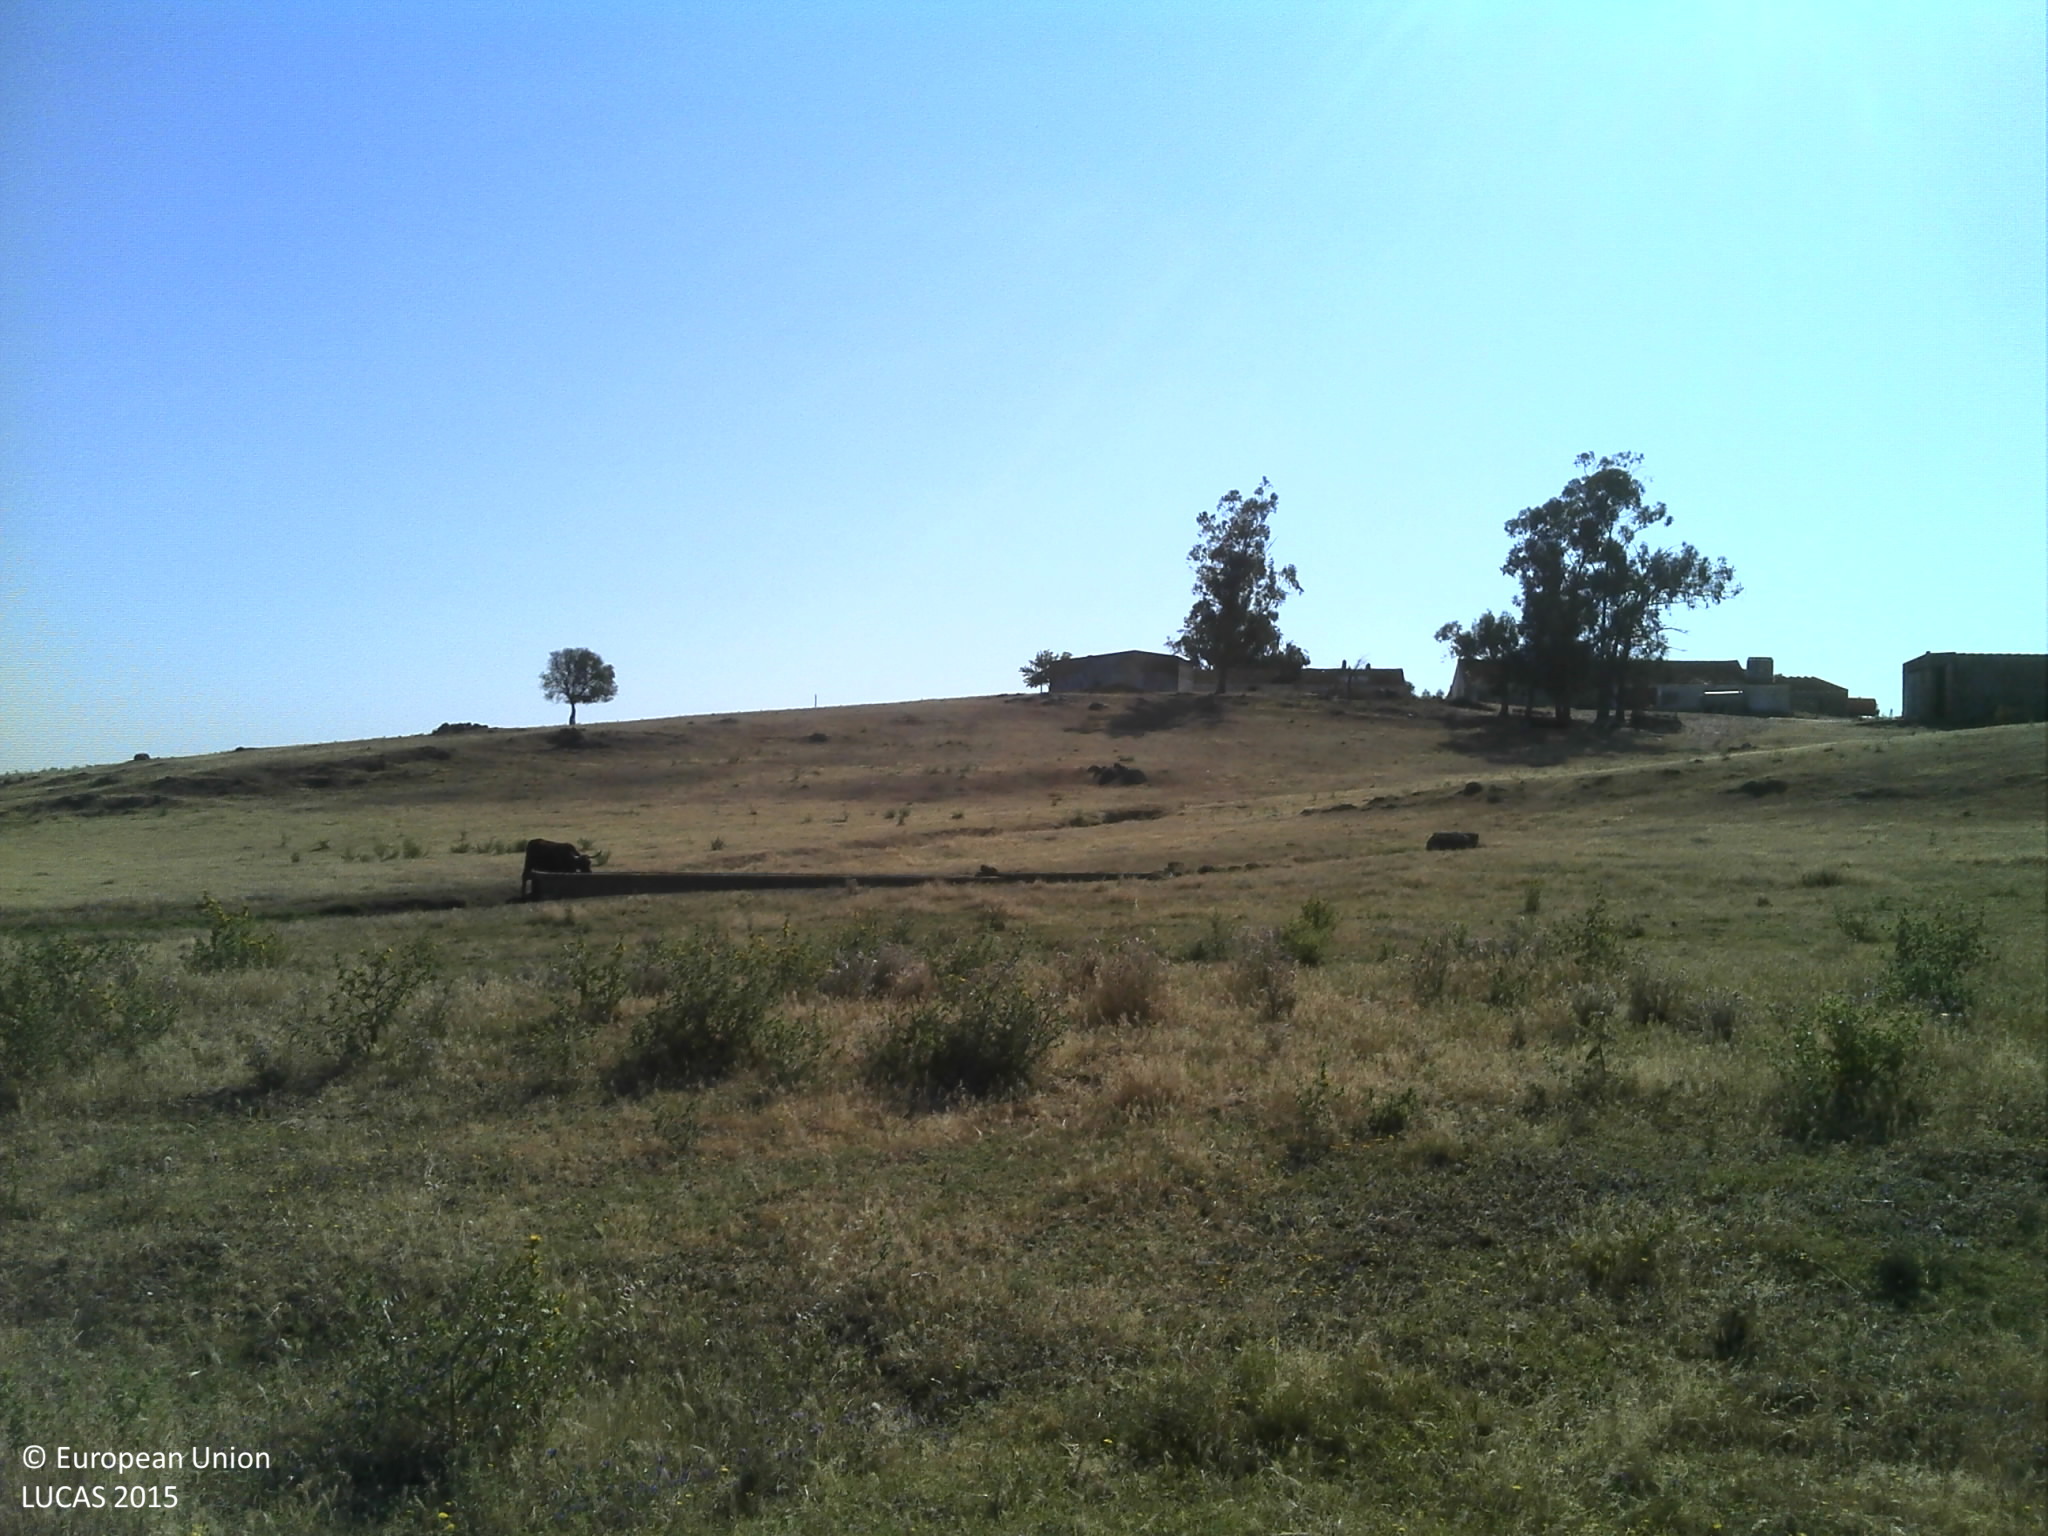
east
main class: Grassland
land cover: Grassland without tree/shrub cover
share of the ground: 25 - 50 %
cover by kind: herbaceous plants 45 %, unconsolidated bare surface 45 %
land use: Agriculture (excluding fallow land and kitchen gardens)
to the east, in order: Grassland without tree/shrub cover; Rivers and streams; Grassland without tree/shrub cover; Tracks; Grassland without tree/shrub cover; Artificial constructions in urban areas
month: June
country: PT
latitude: 38.6514
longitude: -8.0501
